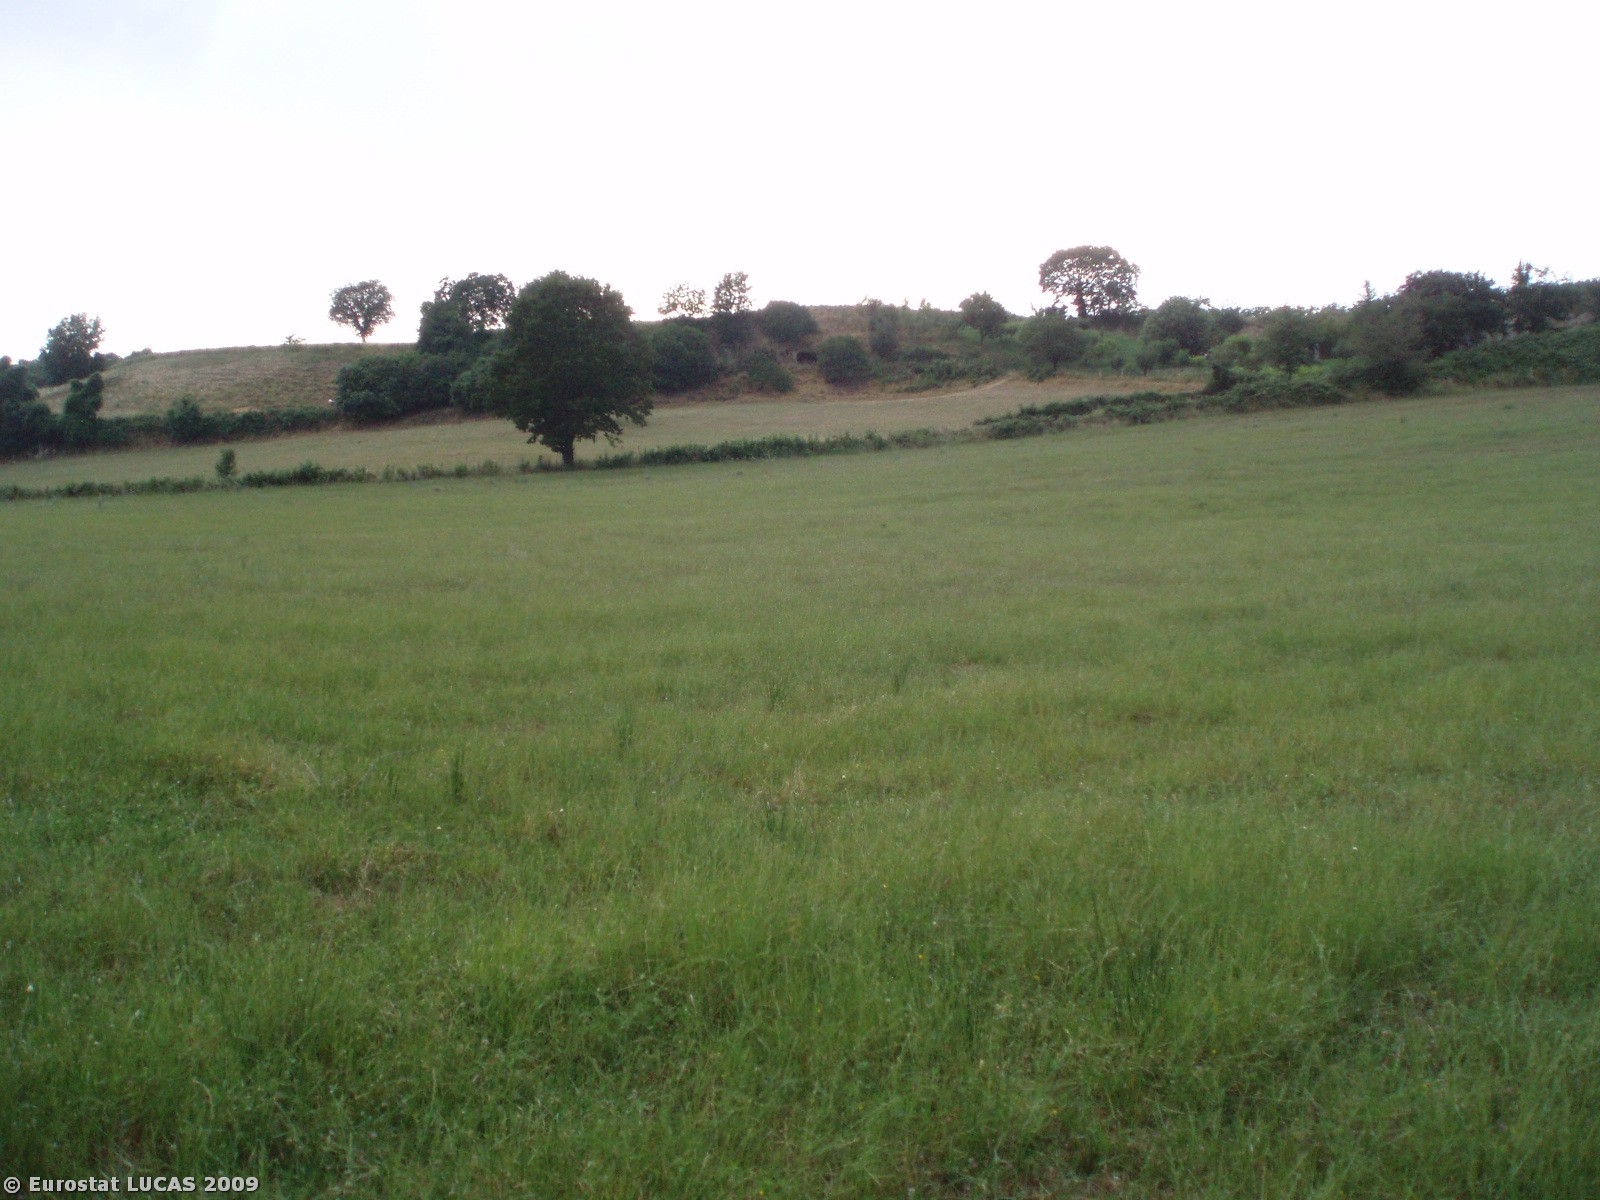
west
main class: Grassland
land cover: Grassland without tree/shrub cover
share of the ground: > 75 %
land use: Agriculture (excluding fallow land and kitchen gardens)
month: June
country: IT
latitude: 42.6415
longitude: 11.5924
